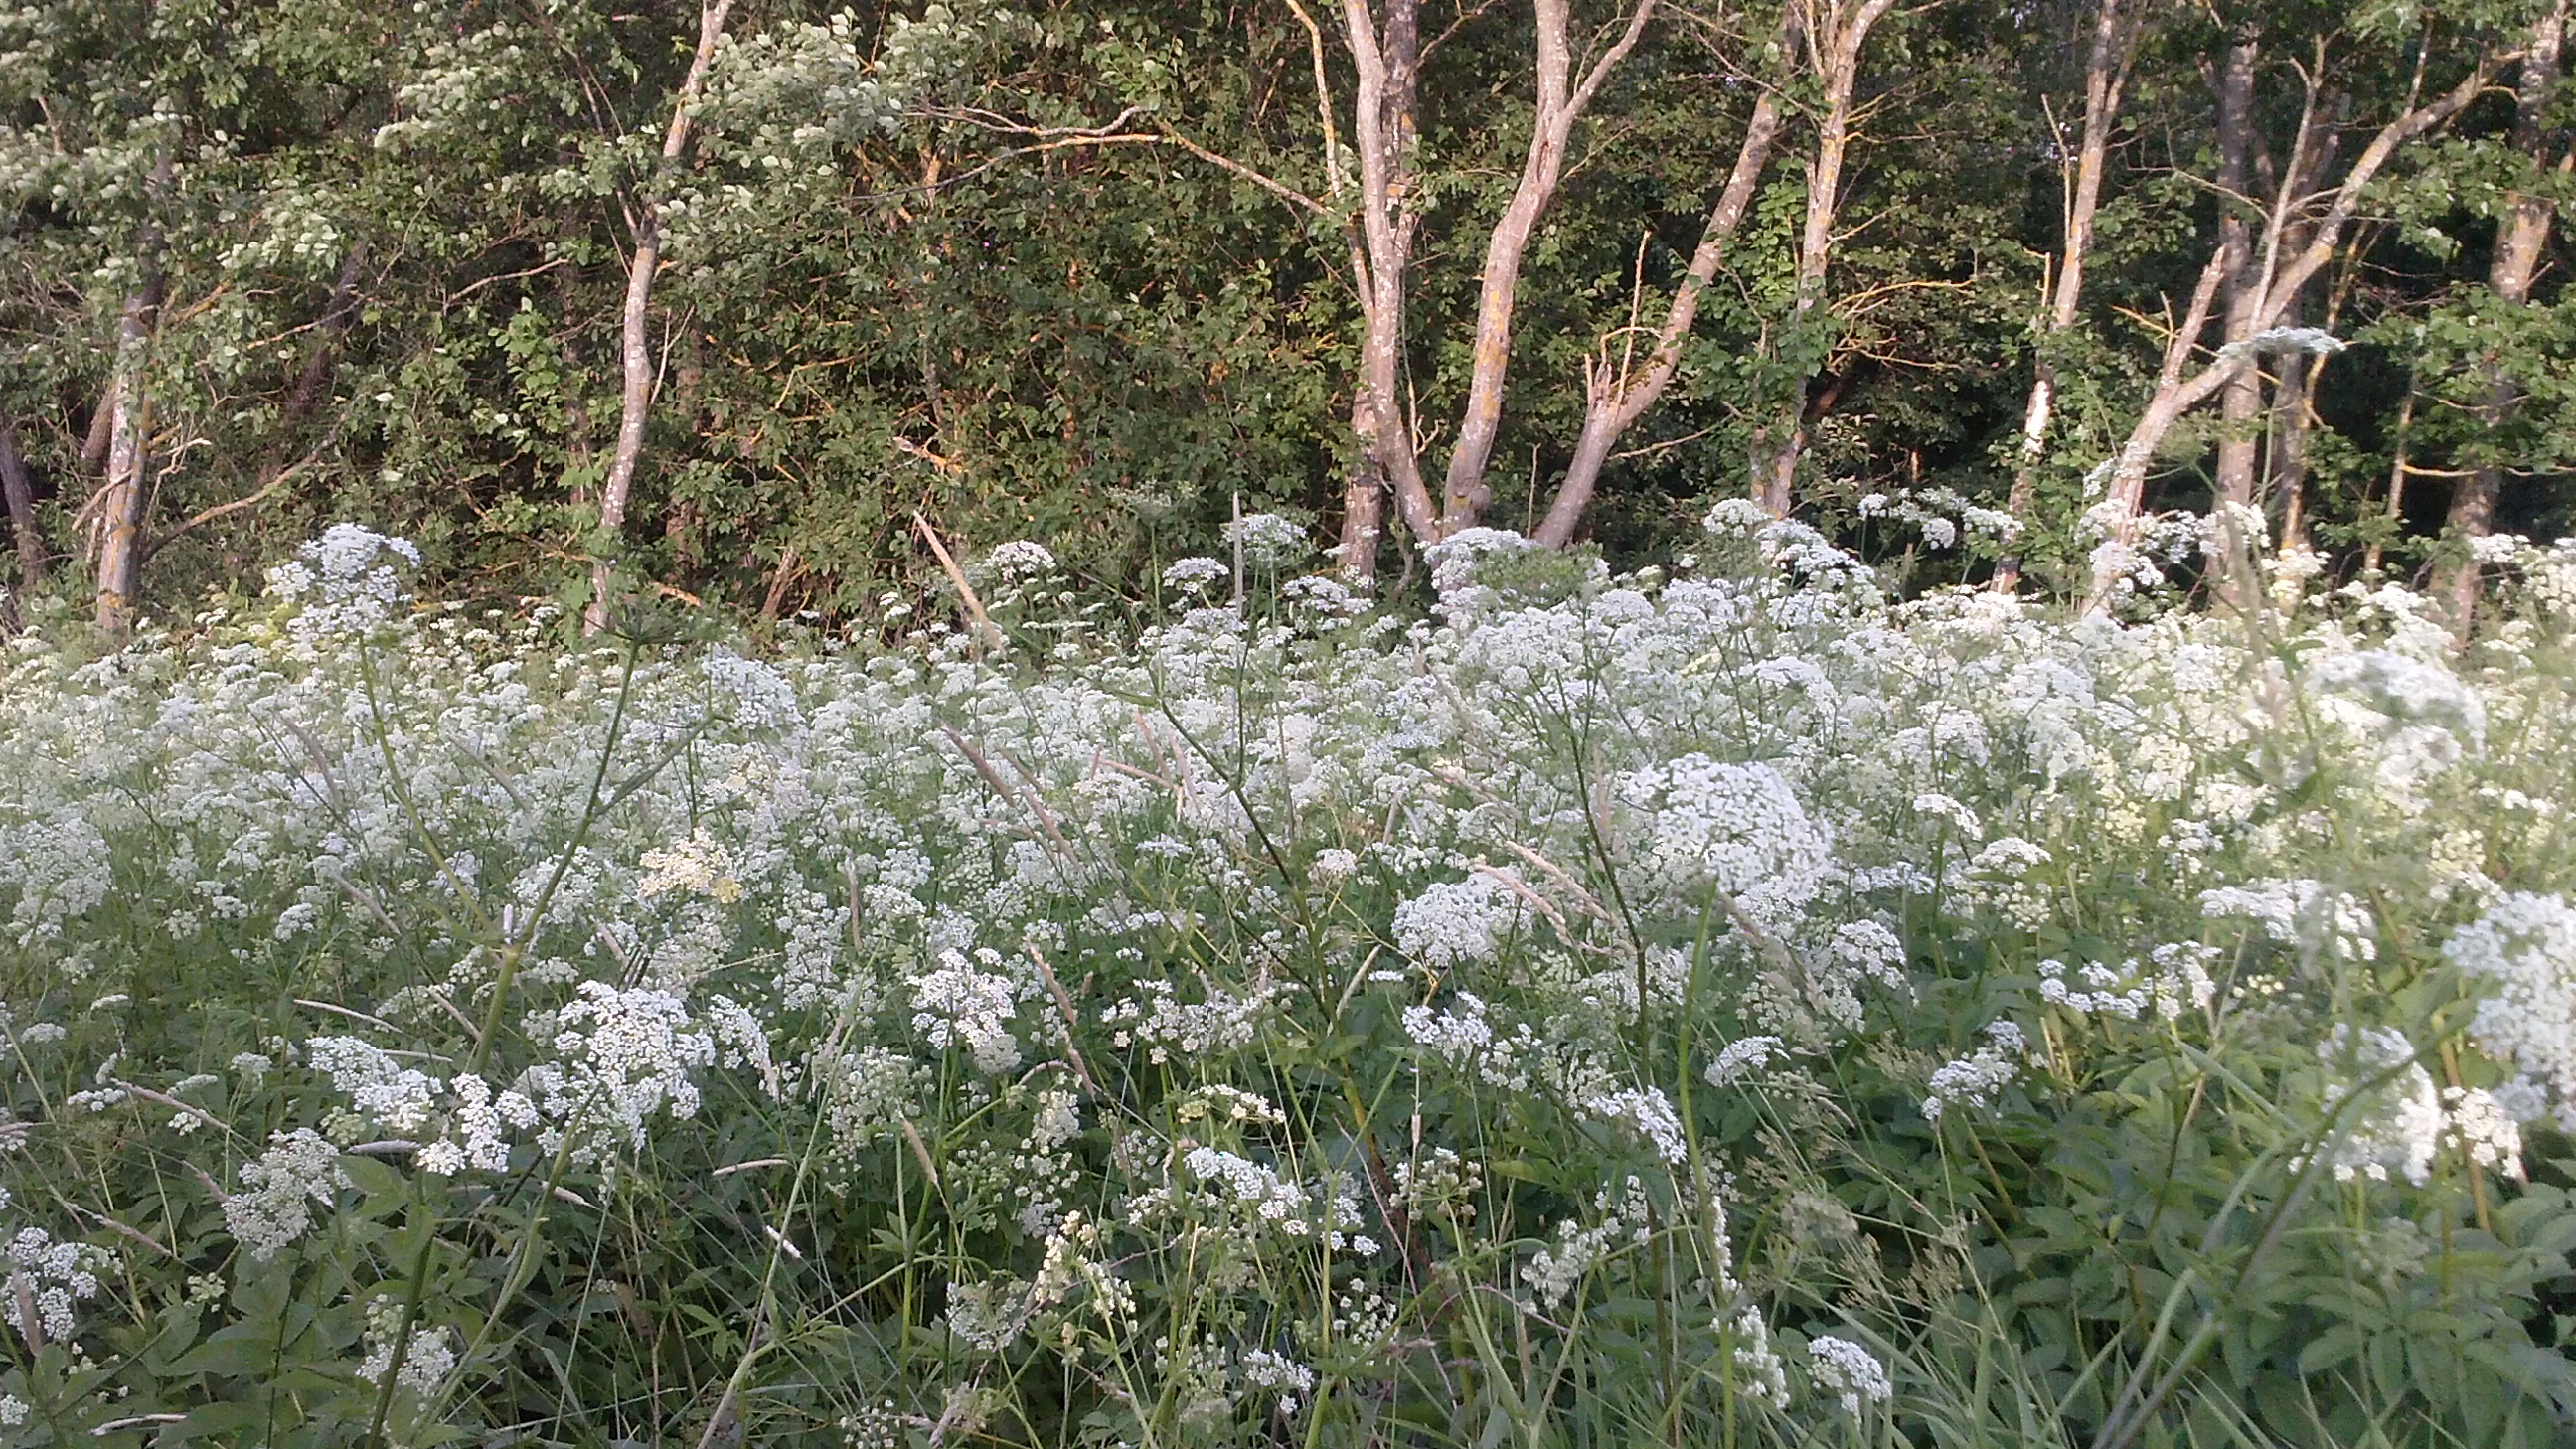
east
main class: Grassland
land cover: Spontaneously vegetated surfaces
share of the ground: > 75 %
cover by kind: herbaceous plants 100 %
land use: Abandoned areas
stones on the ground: 10 - 25 %
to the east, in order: Spontaneously vegetated surfaces; Broadleaved woodland; Inland fresh running water; Broadleaved woodland; Spontaneously vegetated surfaces; Broadleaved woodland; Ditches and canals; Abandoned hedges; Spontaneously vegetated surfaces; Broadleaved woodland; Grassland without tree/shrub cover
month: July
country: LV
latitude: 56.7263
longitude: 27.4847
